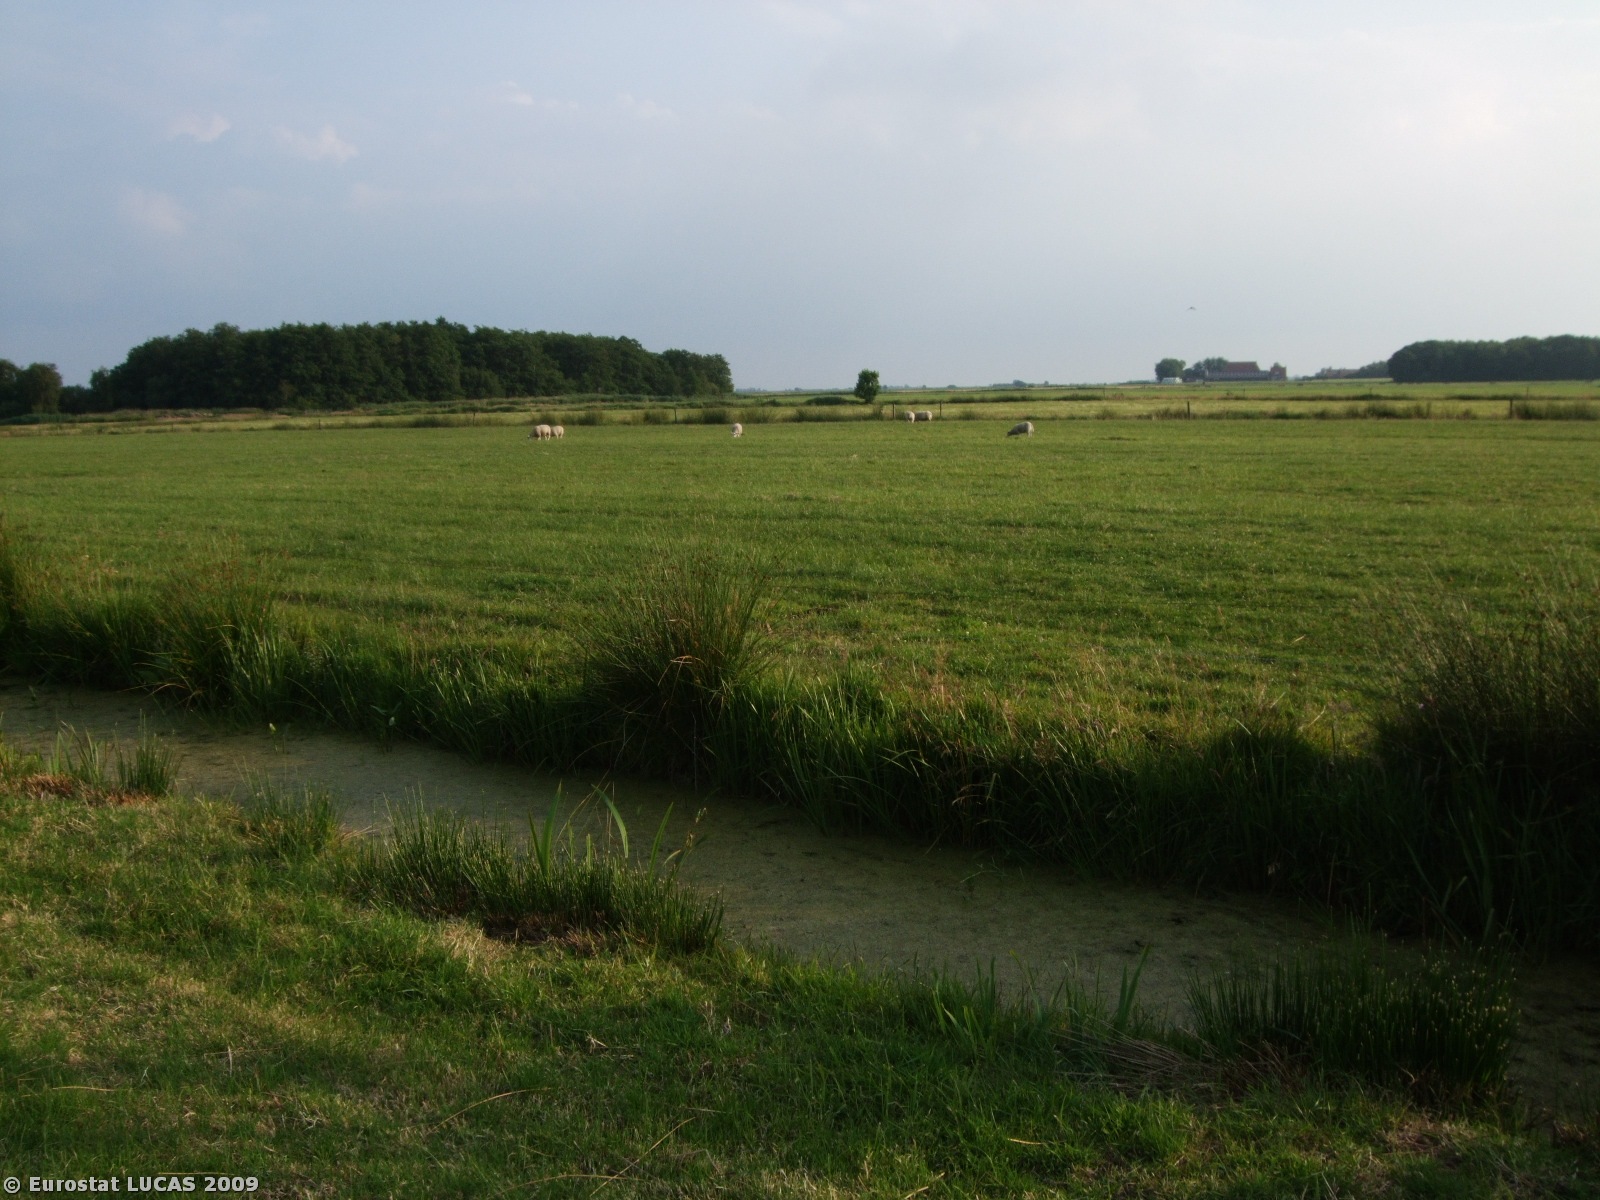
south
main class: Grassland
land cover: Grassland without tree/shrub cover
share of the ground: > 75 %
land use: Agriculture (excluding fallow land and kitchen gardens)
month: June
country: NL
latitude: 52.8916
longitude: 5.6439
